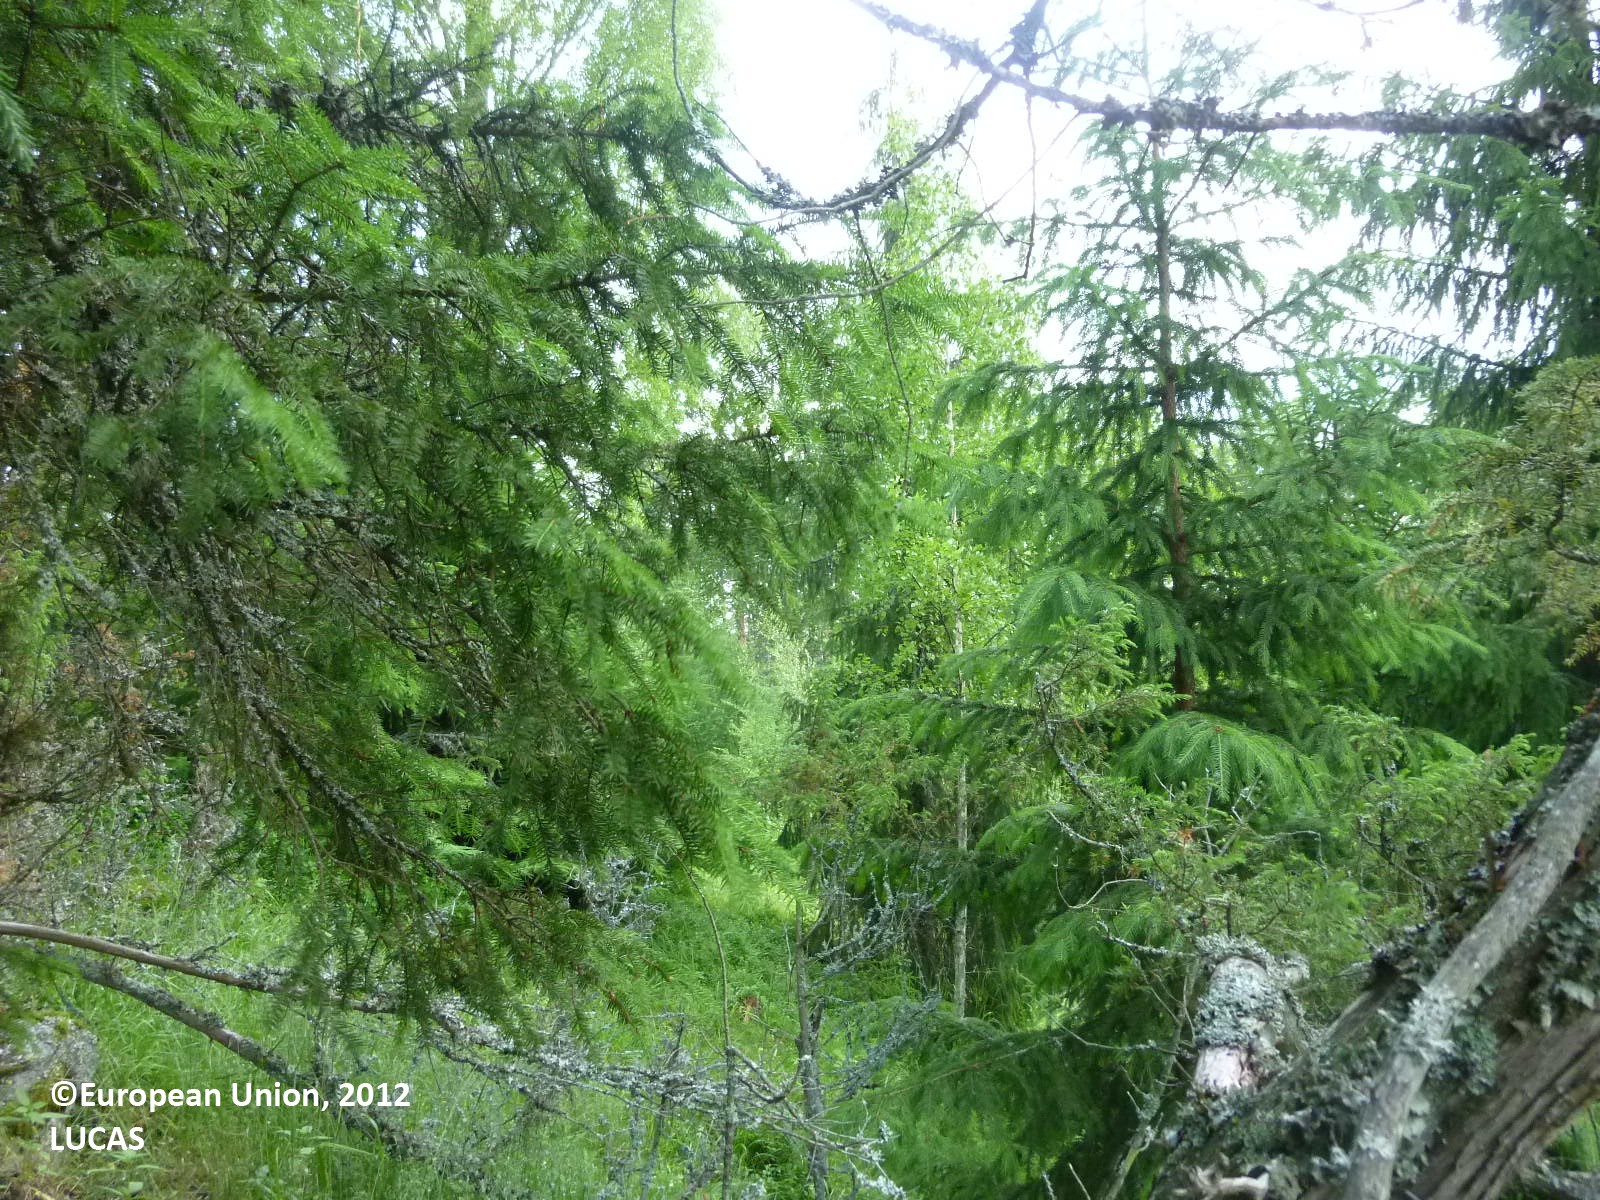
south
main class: Woodland
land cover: Spruce dominated coniferous woodland
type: boreal forest
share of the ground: > 75 %
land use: Forestry
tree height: > 5 m
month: June
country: FI
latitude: 60.3024
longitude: 22.6502
